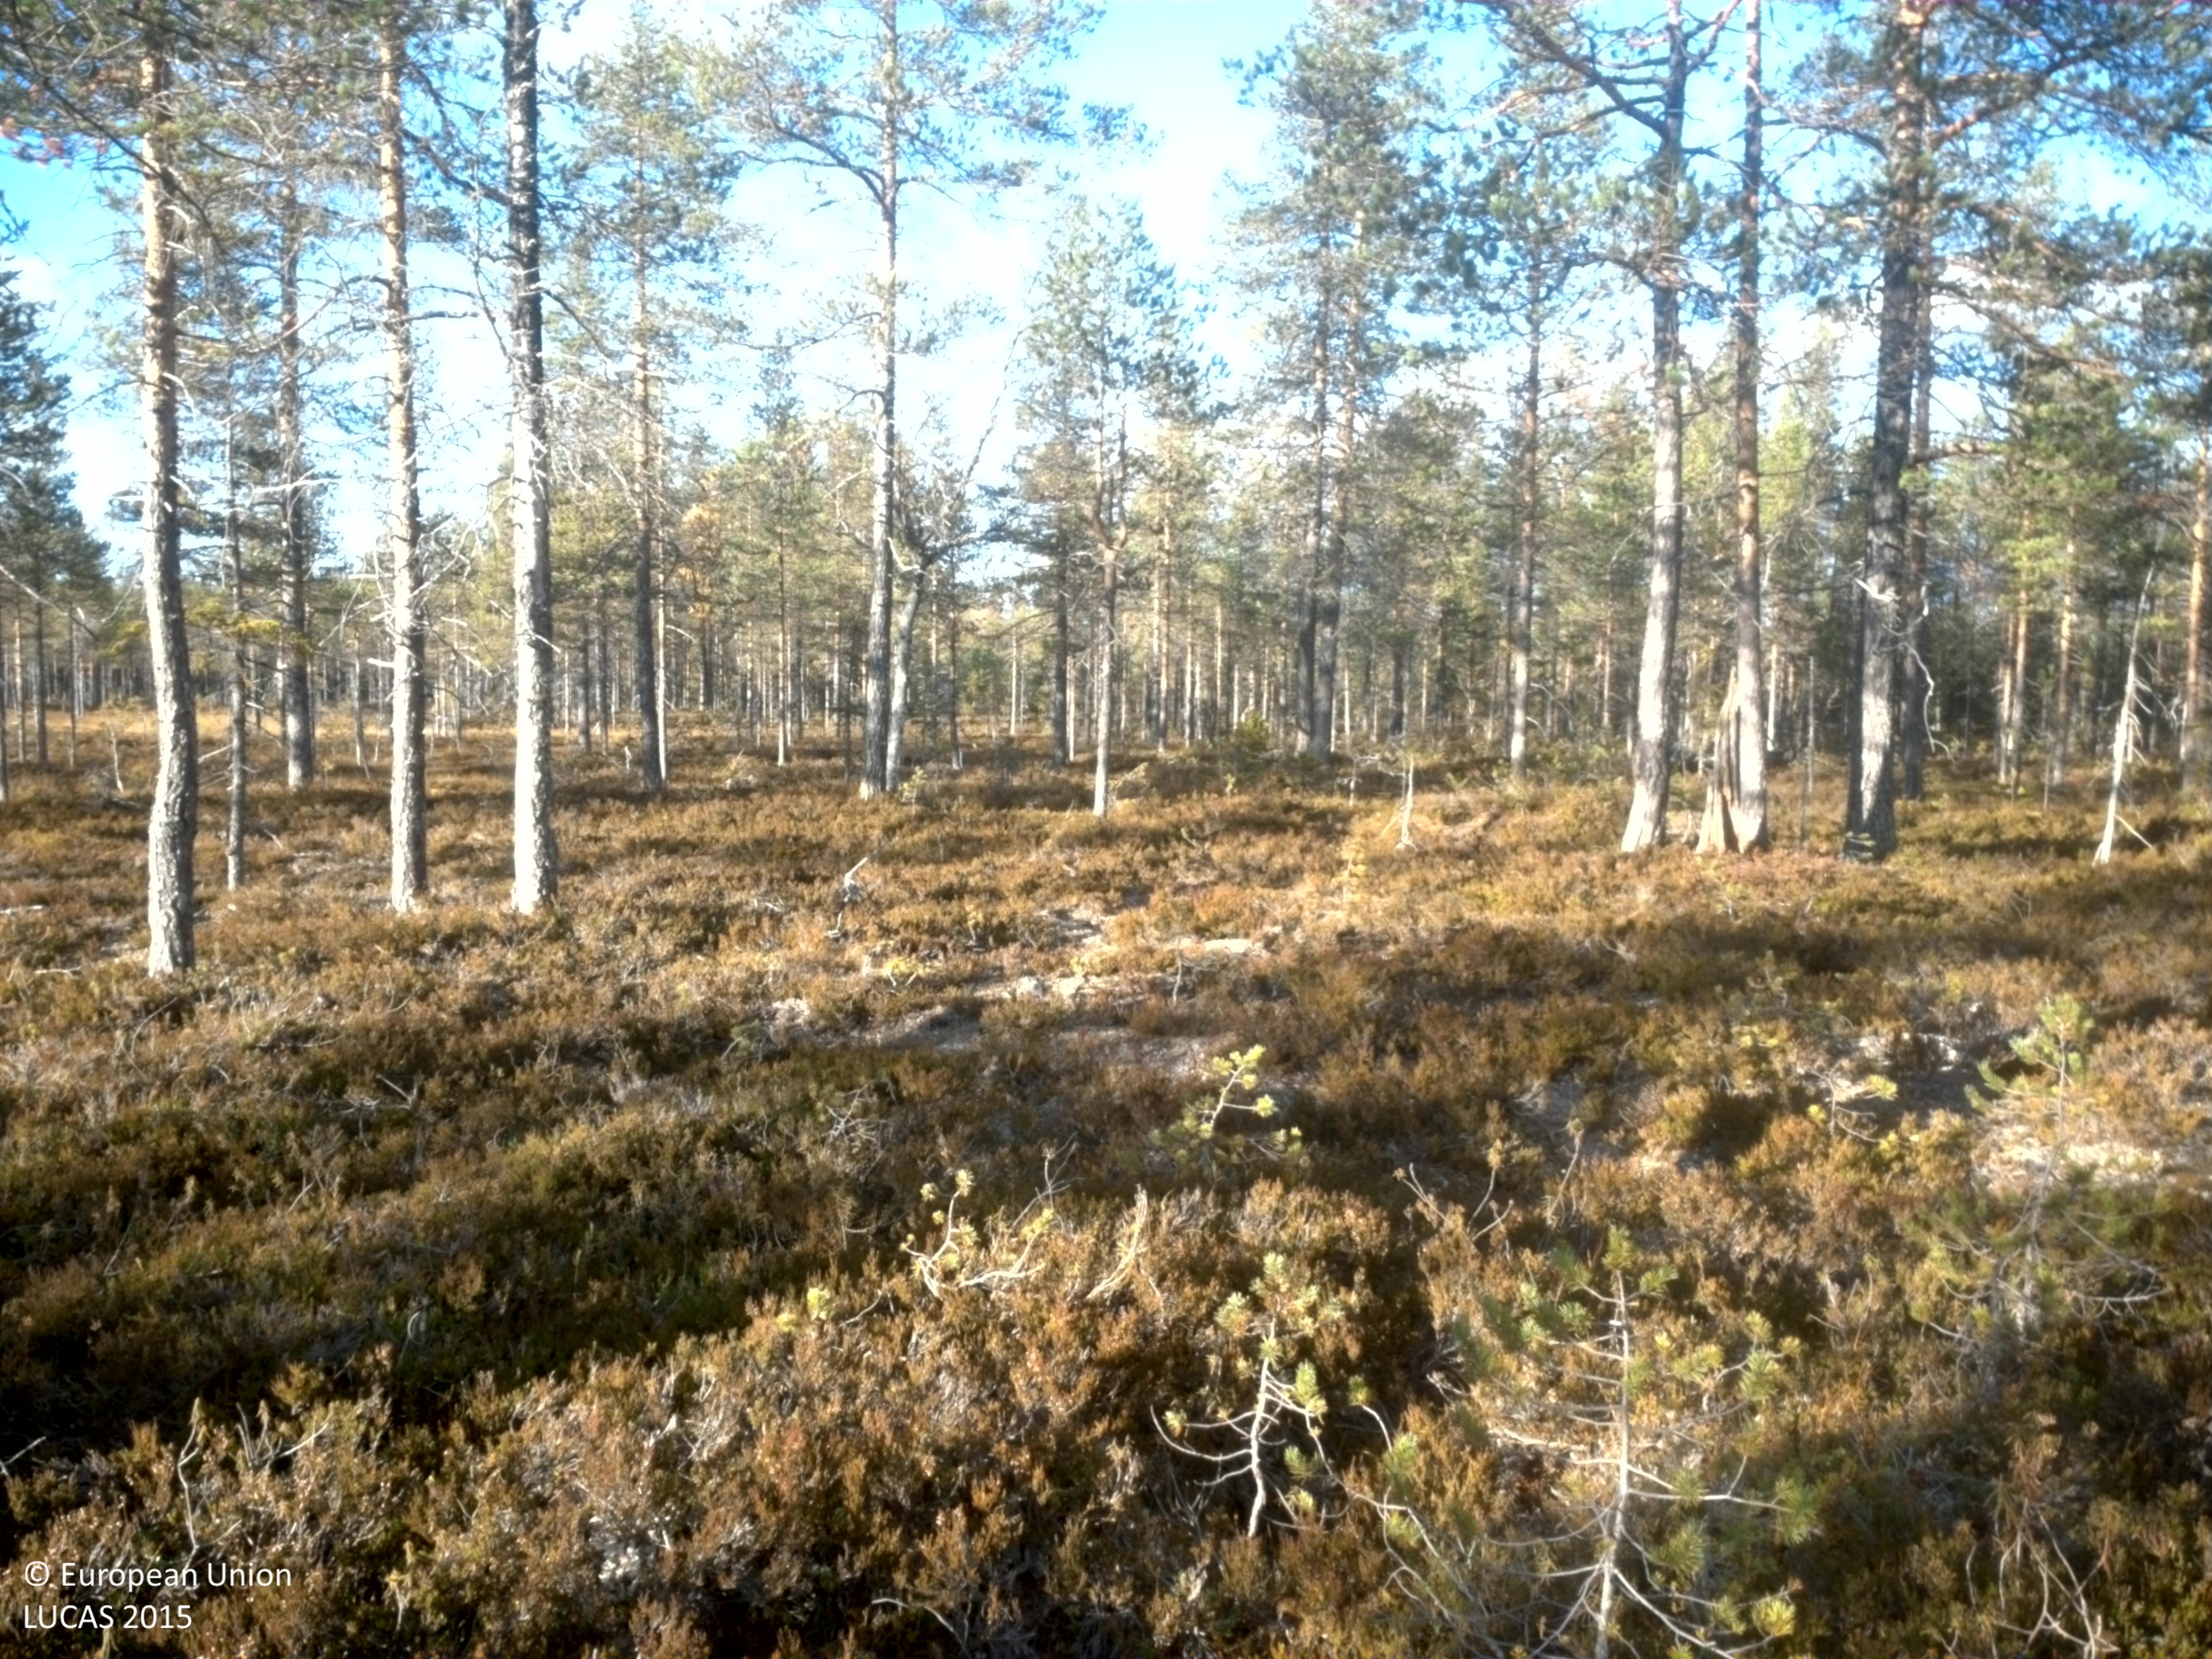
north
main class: Woodland
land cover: Pine dominated coniferous woodland
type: boreal forest
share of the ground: 25 - 50 %
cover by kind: shrubs 50 %, coniferous forest trees 40 %, lichens and mosses 10 %
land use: Forestry
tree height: > 5 m
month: September
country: SE
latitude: 64.2164
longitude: 20.1773
